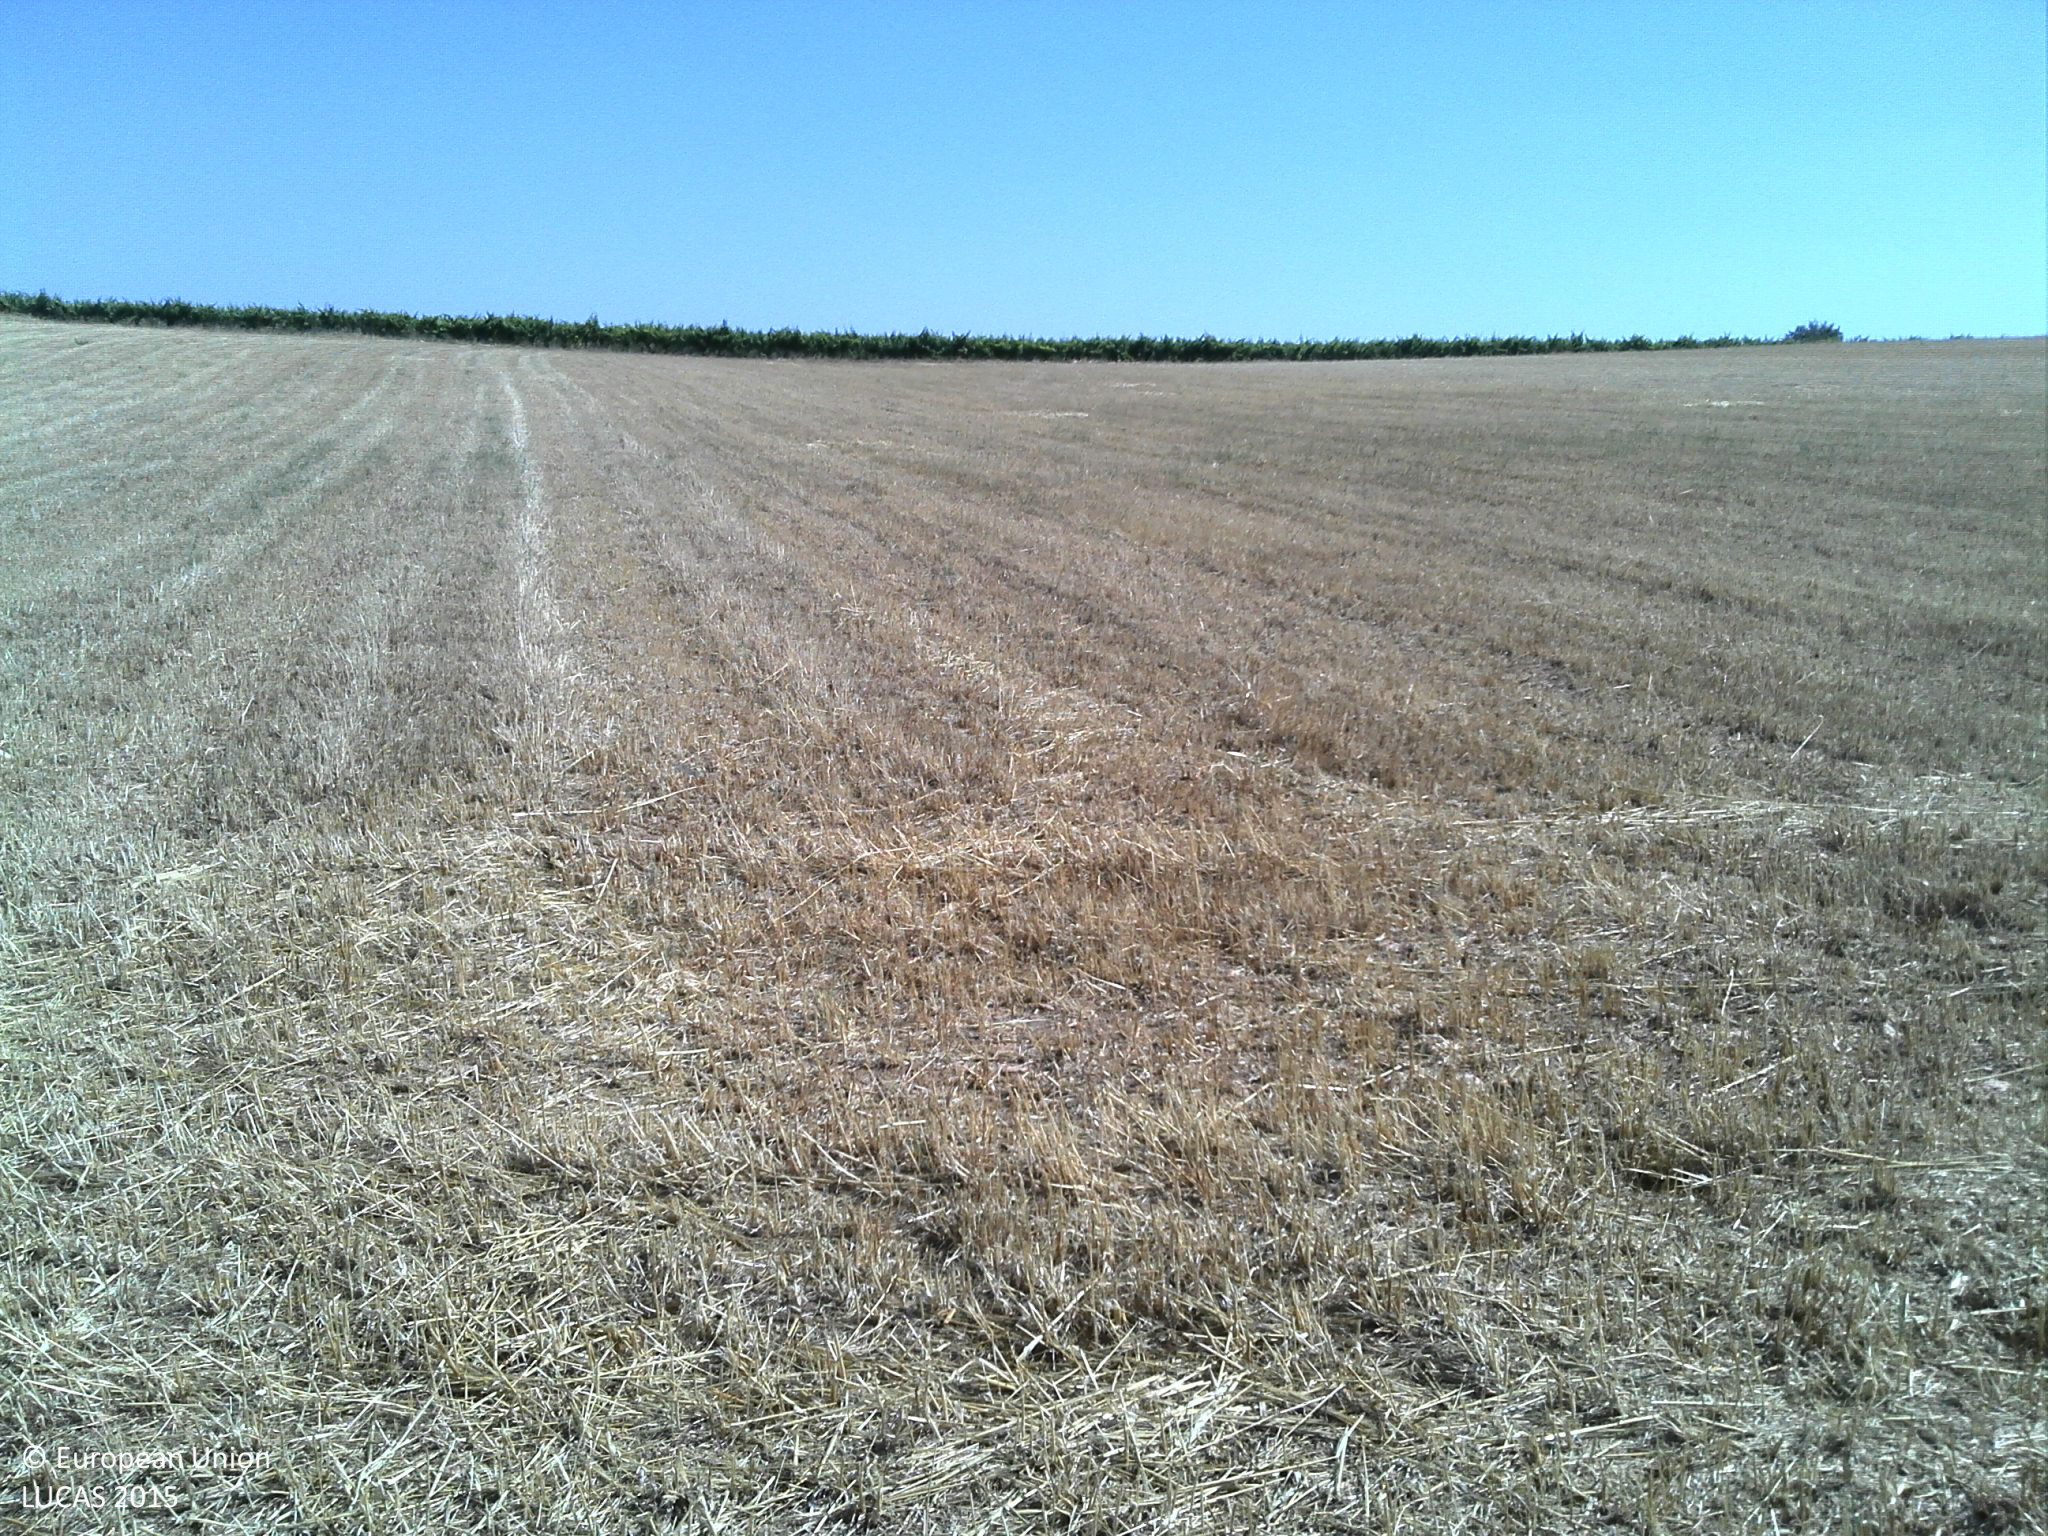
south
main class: Cropland
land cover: Oats
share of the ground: > 75 %
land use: Agriculture (excluding fallow land and kitchen gardens)
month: June
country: PT
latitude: 40.8164
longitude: -6.9011
